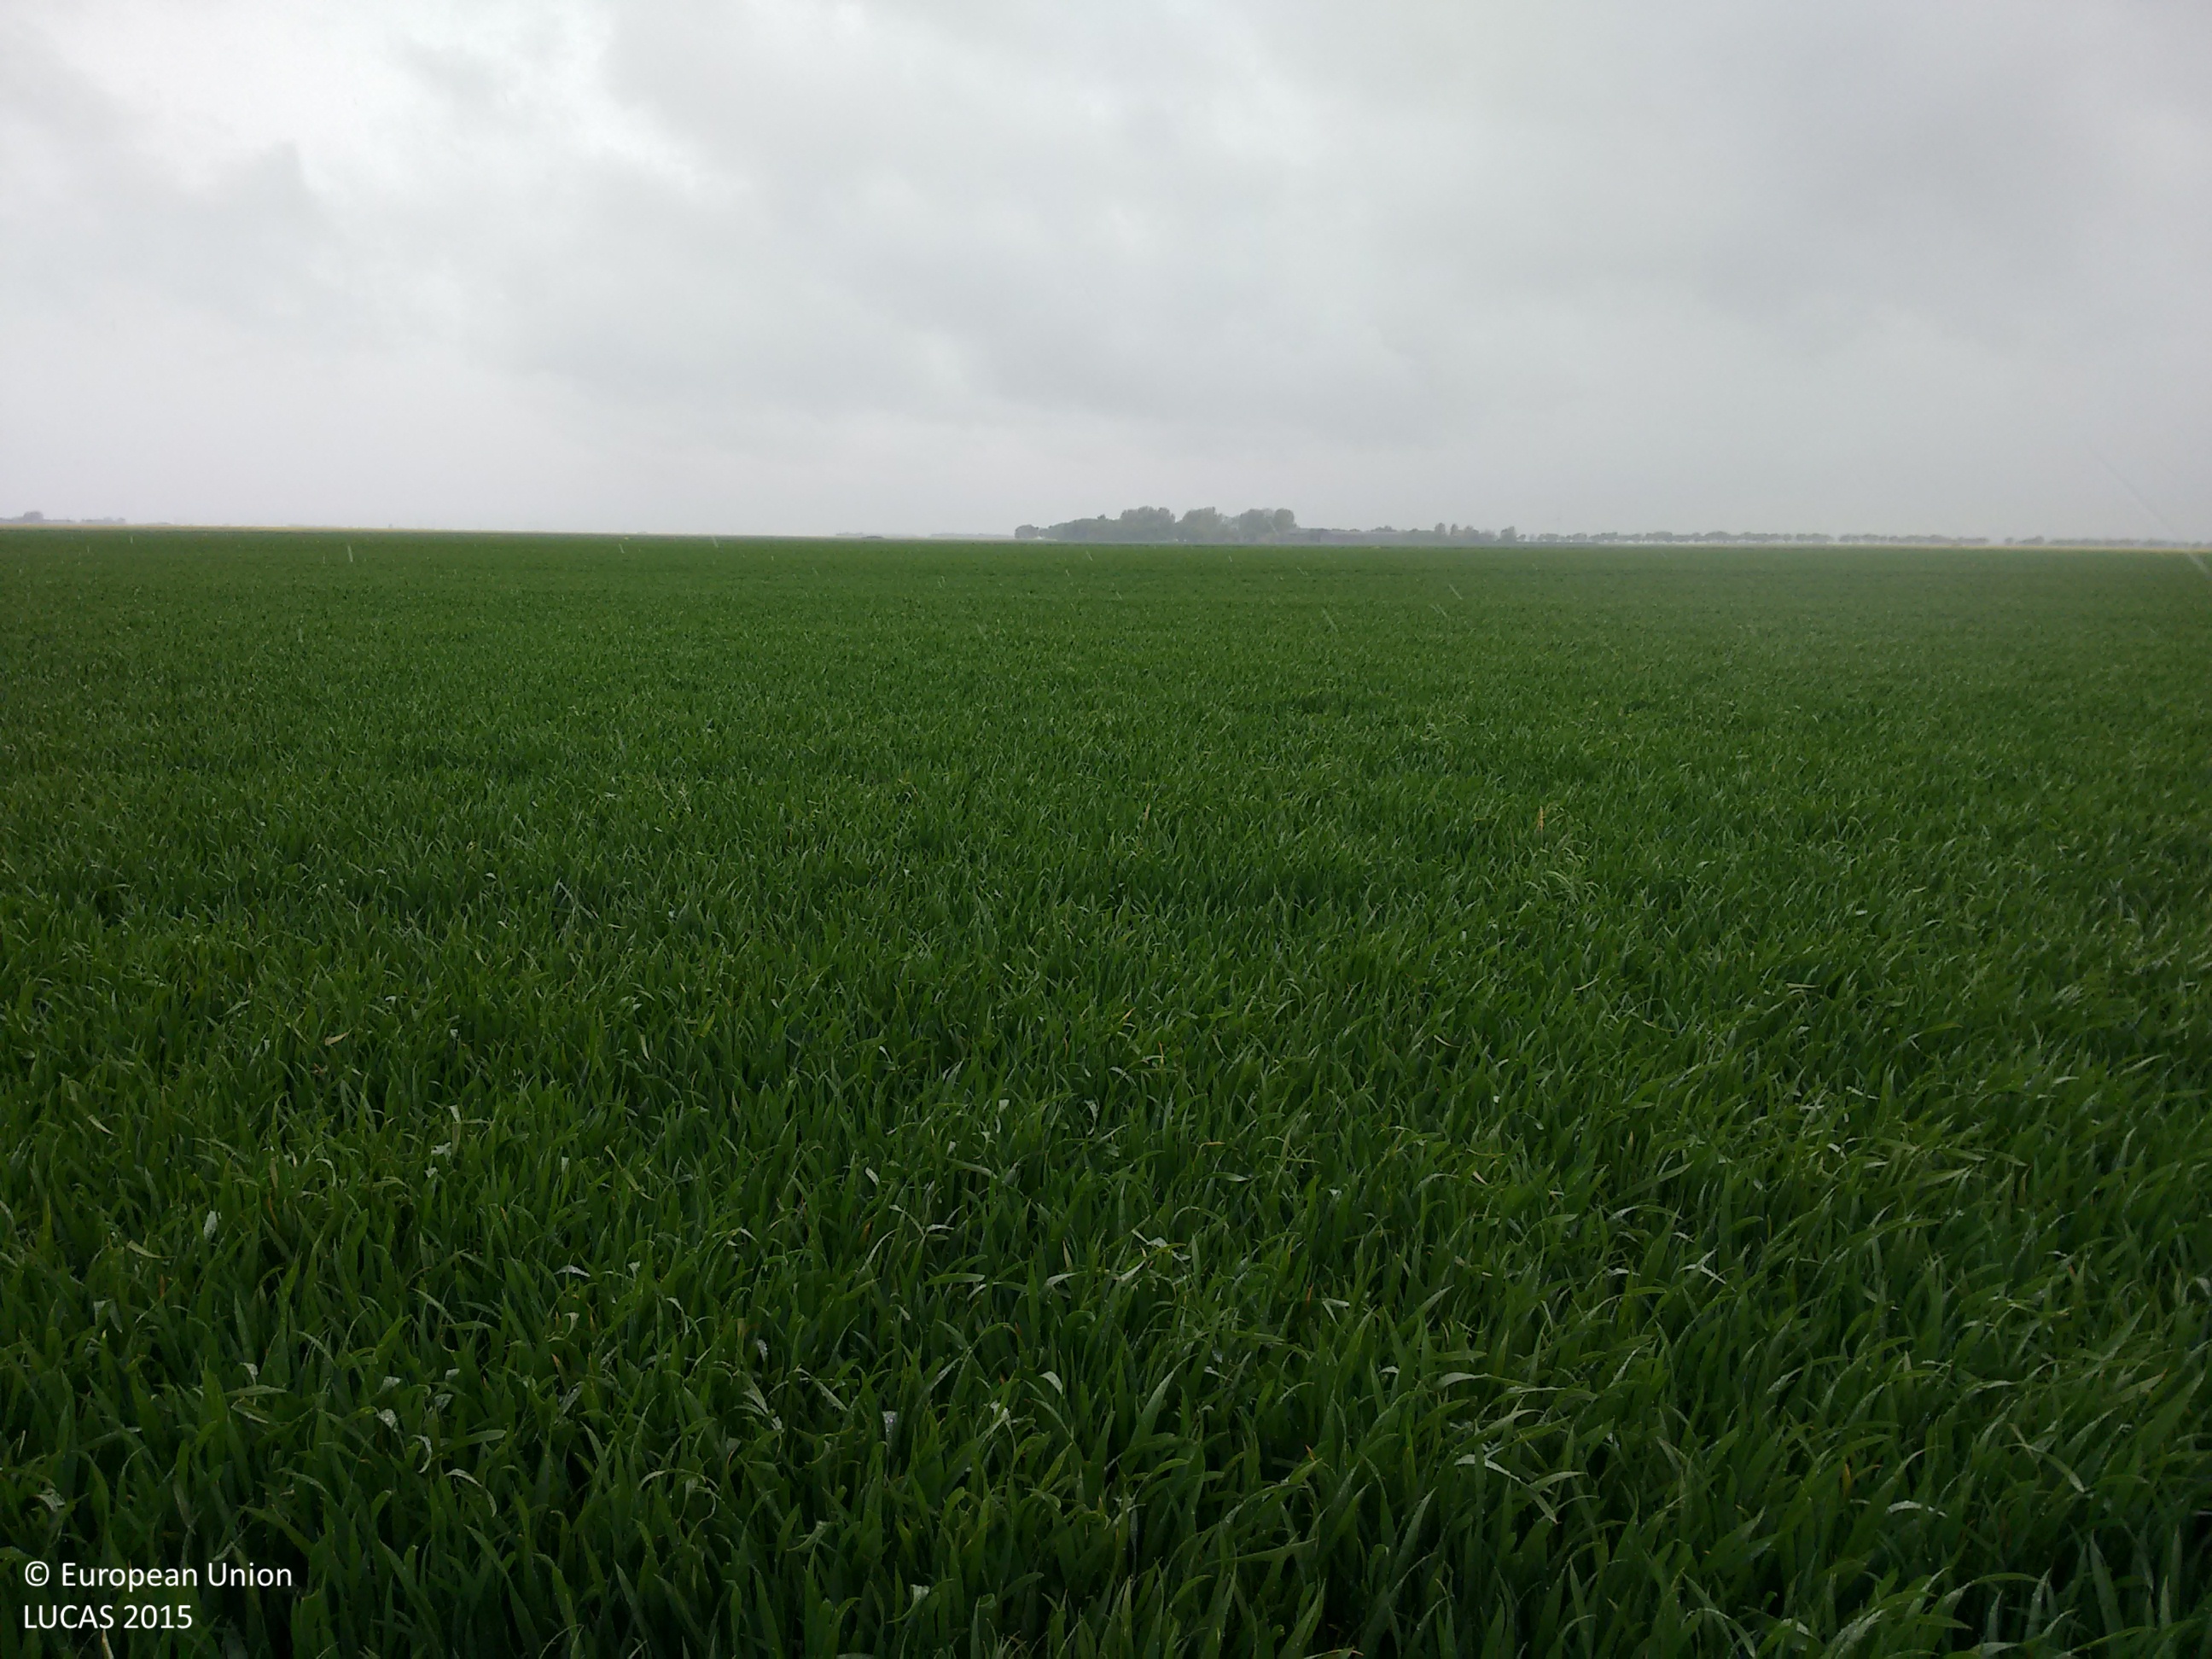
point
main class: Cropland
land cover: Common wheat
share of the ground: > 75 %
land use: Agriculture (excluding fallow land and kitchen gardens)
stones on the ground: < 10 %
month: May
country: GB
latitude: 53.6700
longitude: -0.0674
